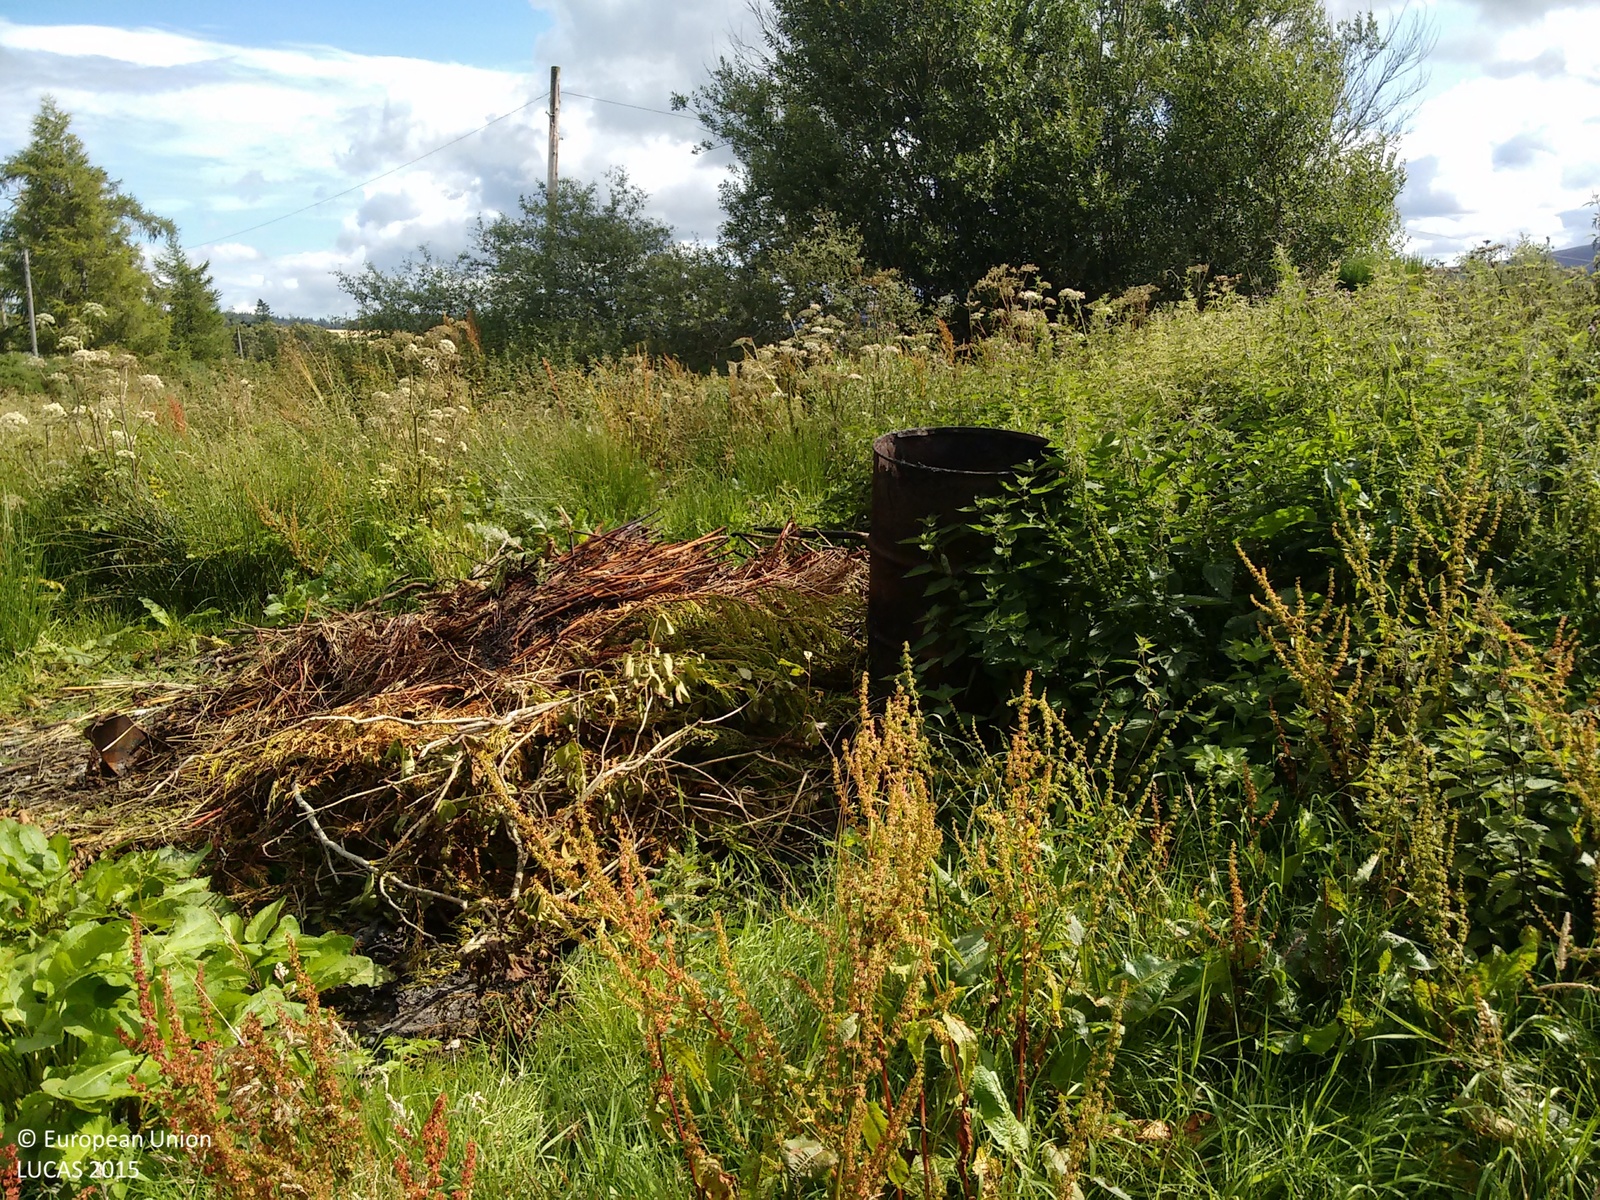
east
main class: Grassland
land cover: Grassland with sparse tree/shrub cover
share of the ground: > 75 %
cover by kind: herbaceous plants 95 %, broadleaved forest trees 5 %
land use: Abandoned areas
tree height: > 5 m
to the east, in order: Grassland with sparse tree/shrub cover; Fences; Abandoned hedges; Electric lines; Grassland without tree/shrub cover; Electric lines; Grassland without tree/shrub cover
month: August
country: GB
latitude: 57.4645
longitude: -3.2867
